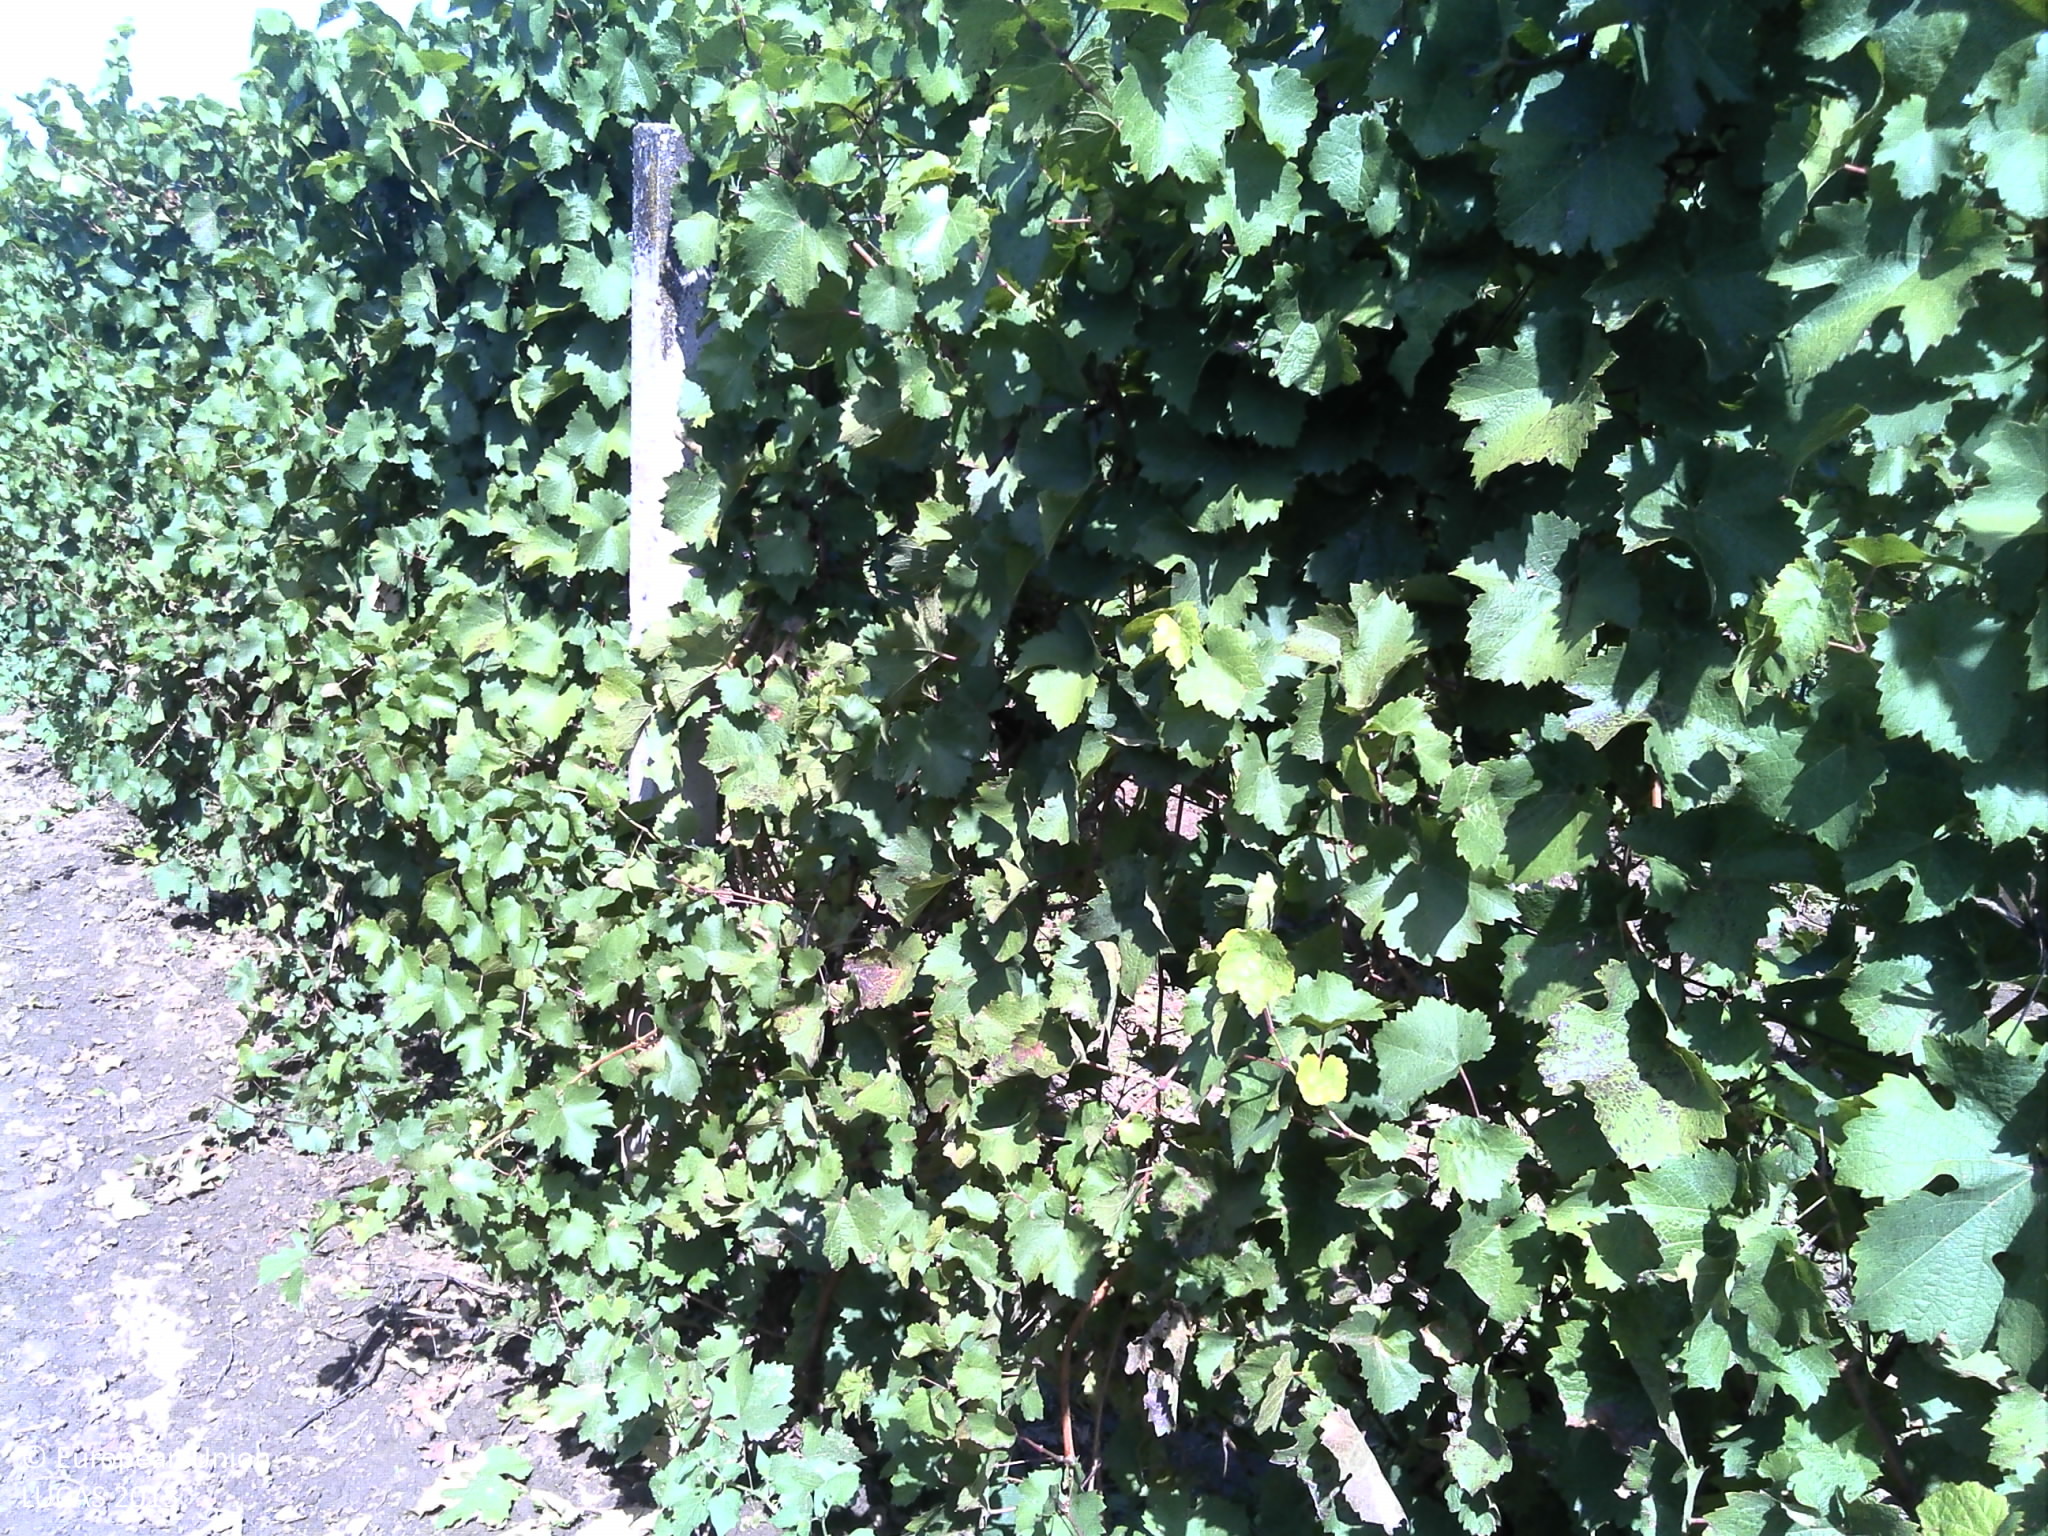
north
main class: Cropland
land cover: Vineyards
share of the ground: 10 - 25 %
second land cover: Other bare soil
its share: > 75 %
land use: Agriculture (excluding fallow land and kitchen gardens)
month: September
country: HR
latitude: 45.3321
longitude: 19.0557
